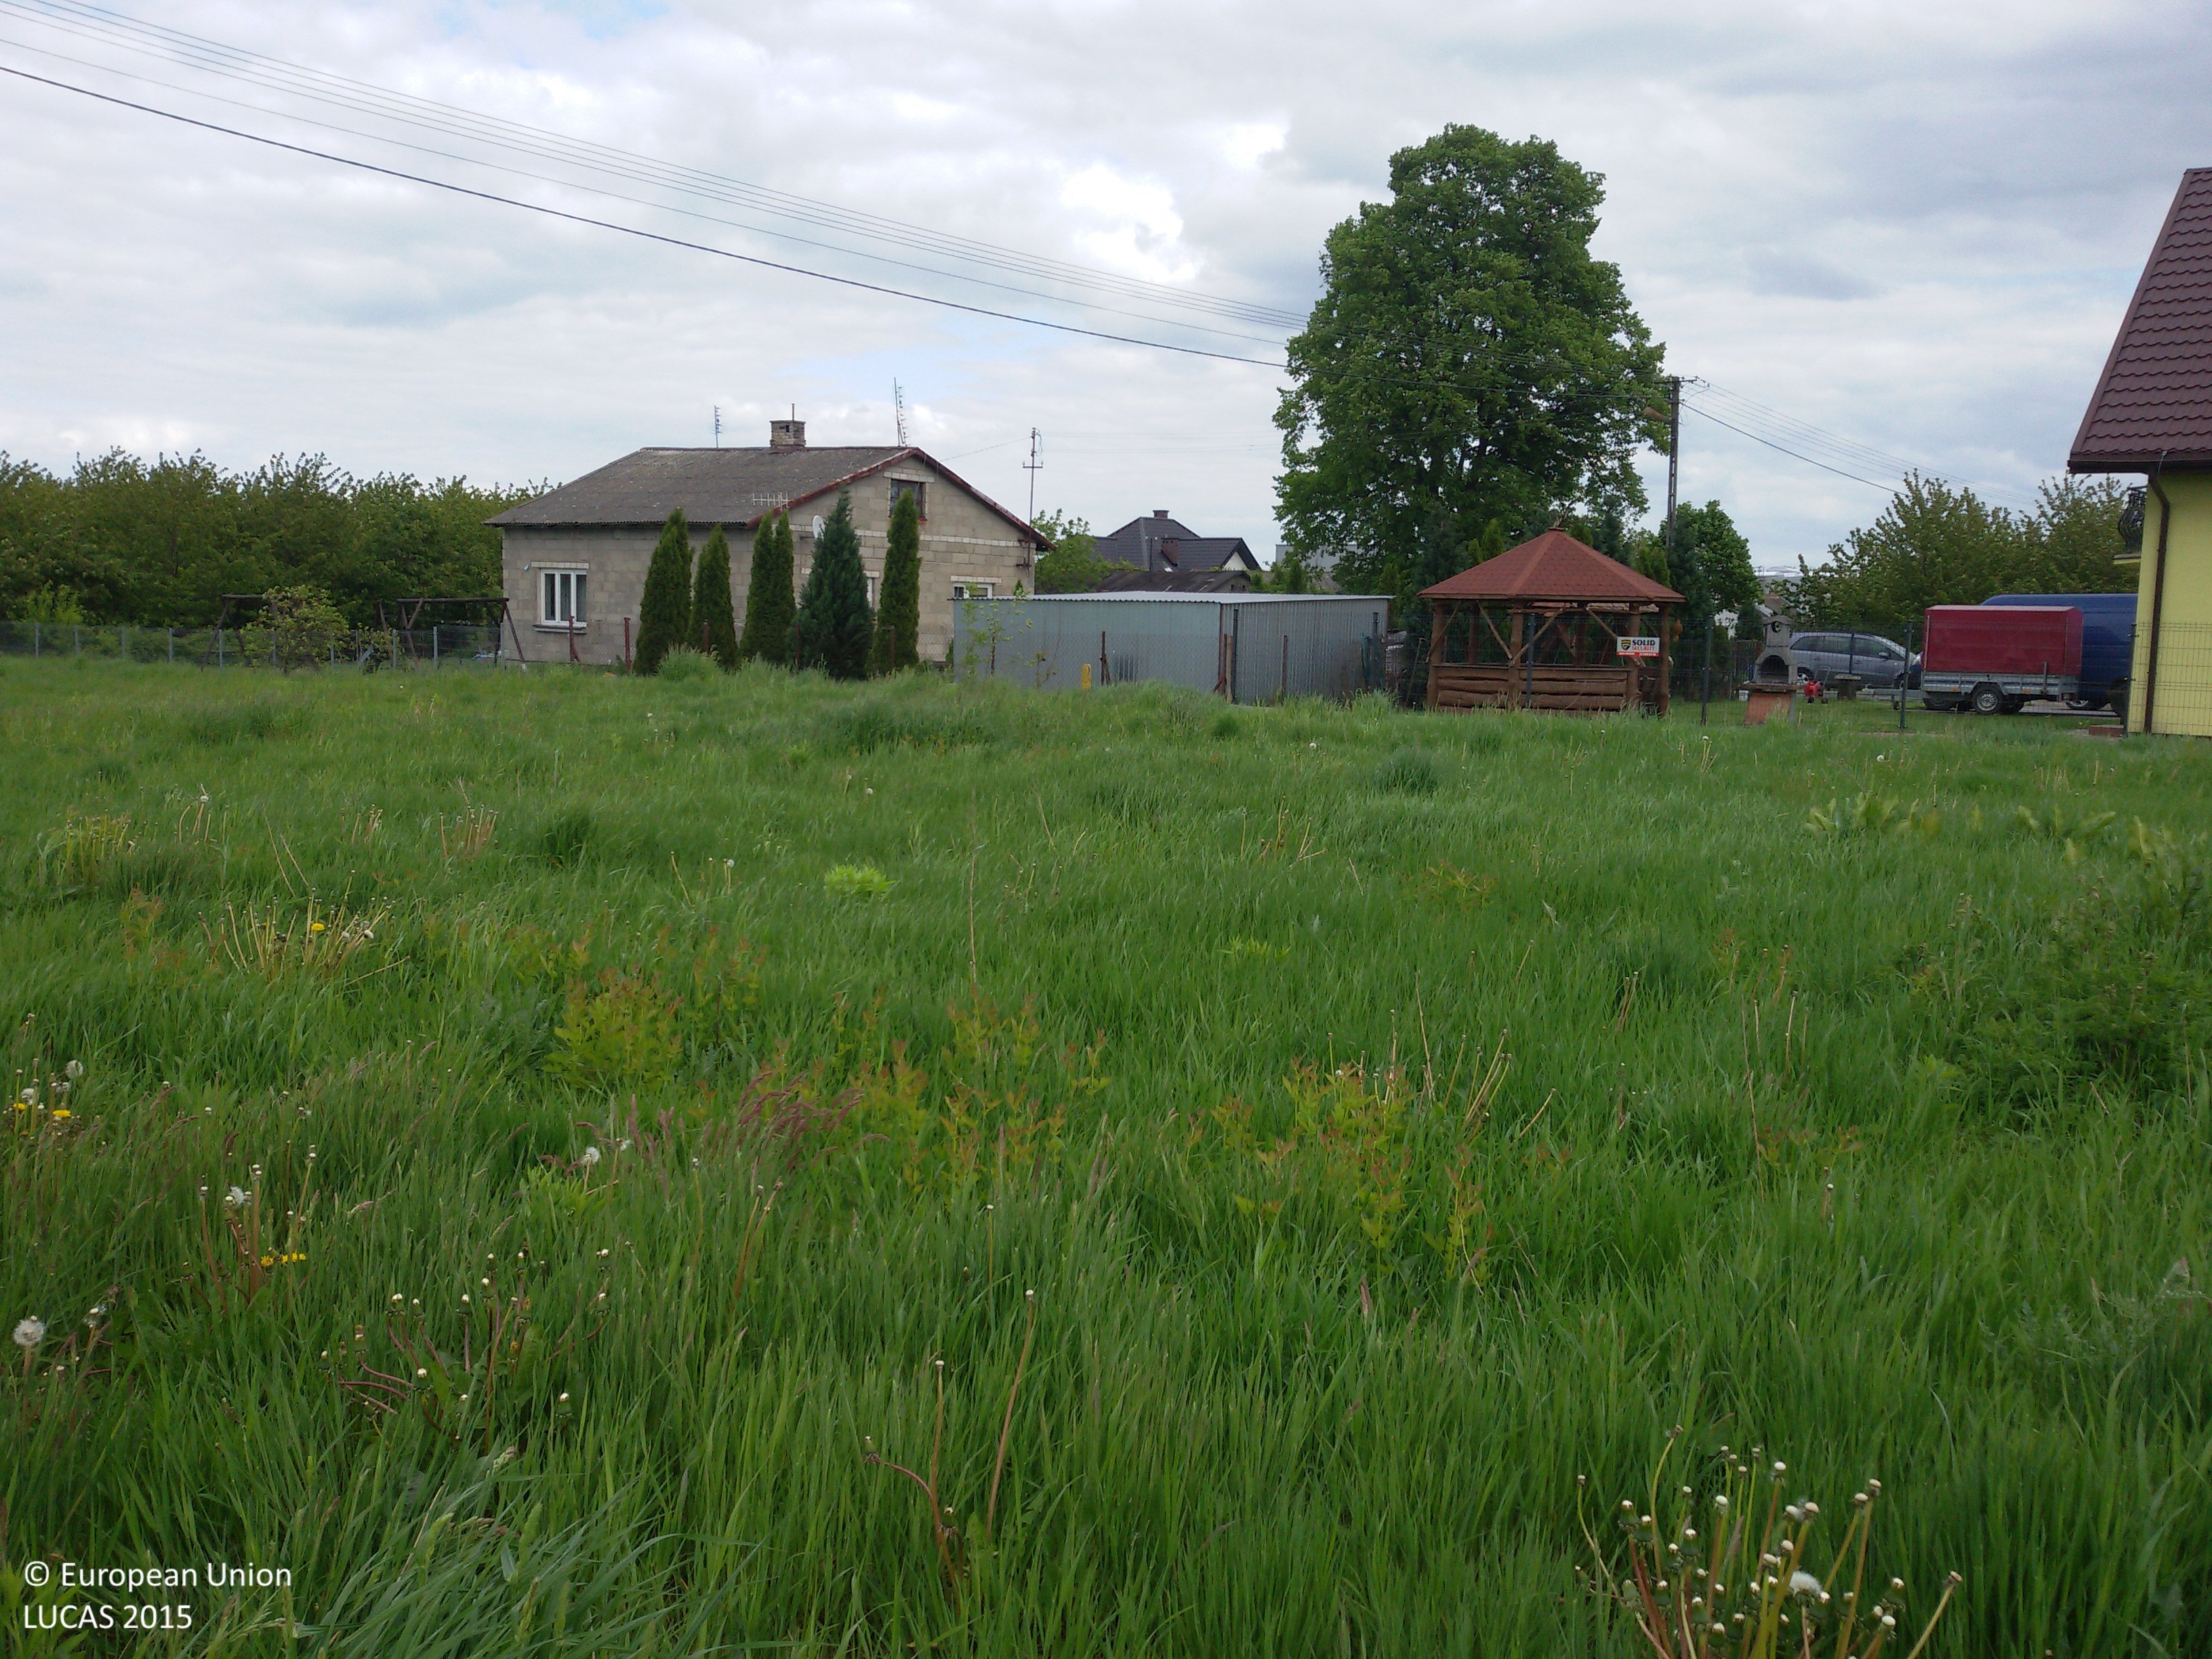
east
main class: Grassland
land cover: Grassland without tree/shrub cover
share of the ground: > 75 %
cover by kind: herbaceous plants 100 %
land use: Agriculture (excluding fallow land and kitchen gardens)
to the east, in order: Grassland without tree/shrub cover; Artificial constructions in urban areas; Cherry fruit; Fences; Apple fruit; Artificial constructions in urban areas; Apple fruit
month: May
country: PL
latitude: 51.9056
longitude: 20.7538
